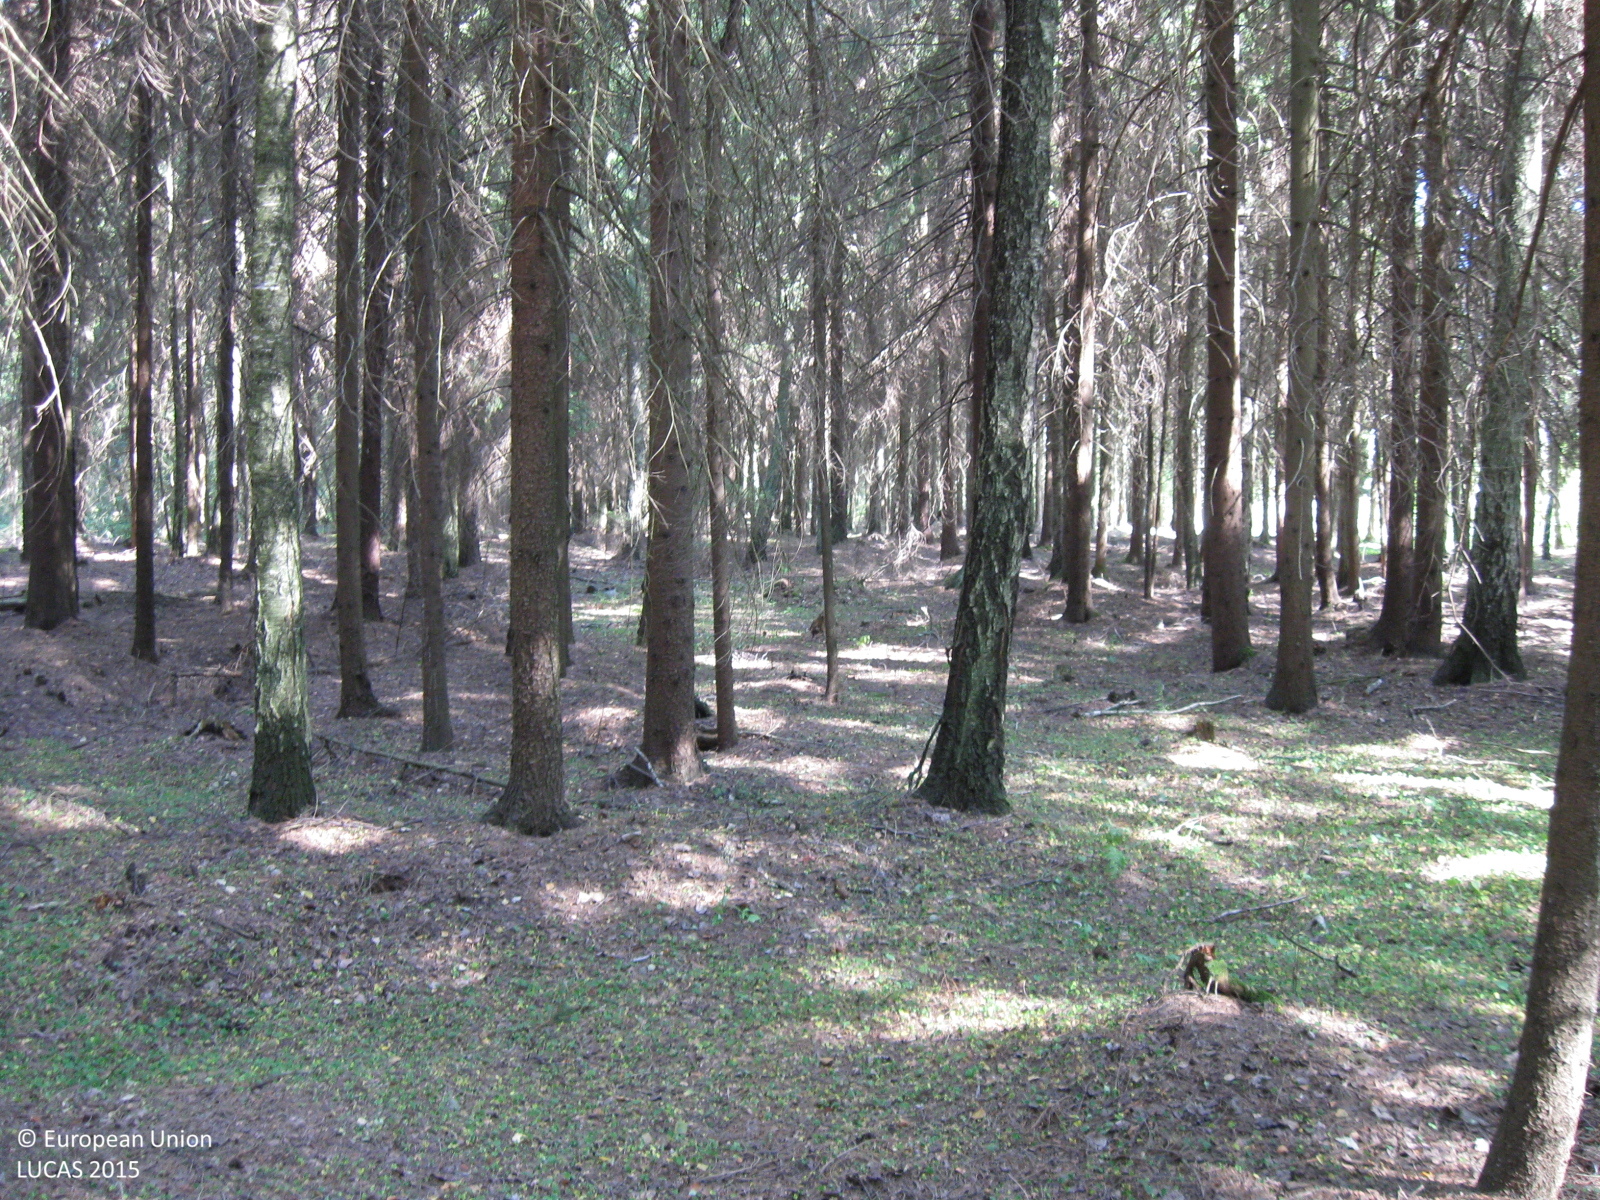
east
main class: Woodland
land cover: Spruce dominated coniferous woodland
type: hemiboreal forest and nemoral coniferous forest and mixed broadleaved-coniferous forest
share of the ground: > 75 %
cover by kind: coniferous forest trees 85 %, broadleaved forest trees 10 %, herbaceous plants 5 %
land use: Forestry
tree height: > 5 m
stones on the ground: < 10 %
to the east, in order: Spruce dominated coniferous woodland; Spruce dominated mixed woodland; Ditches and canals; Grass margins; Tracks; Grassland without tree/shrub cover
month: August
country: LT
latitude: 55.2660
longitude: 22.4782
